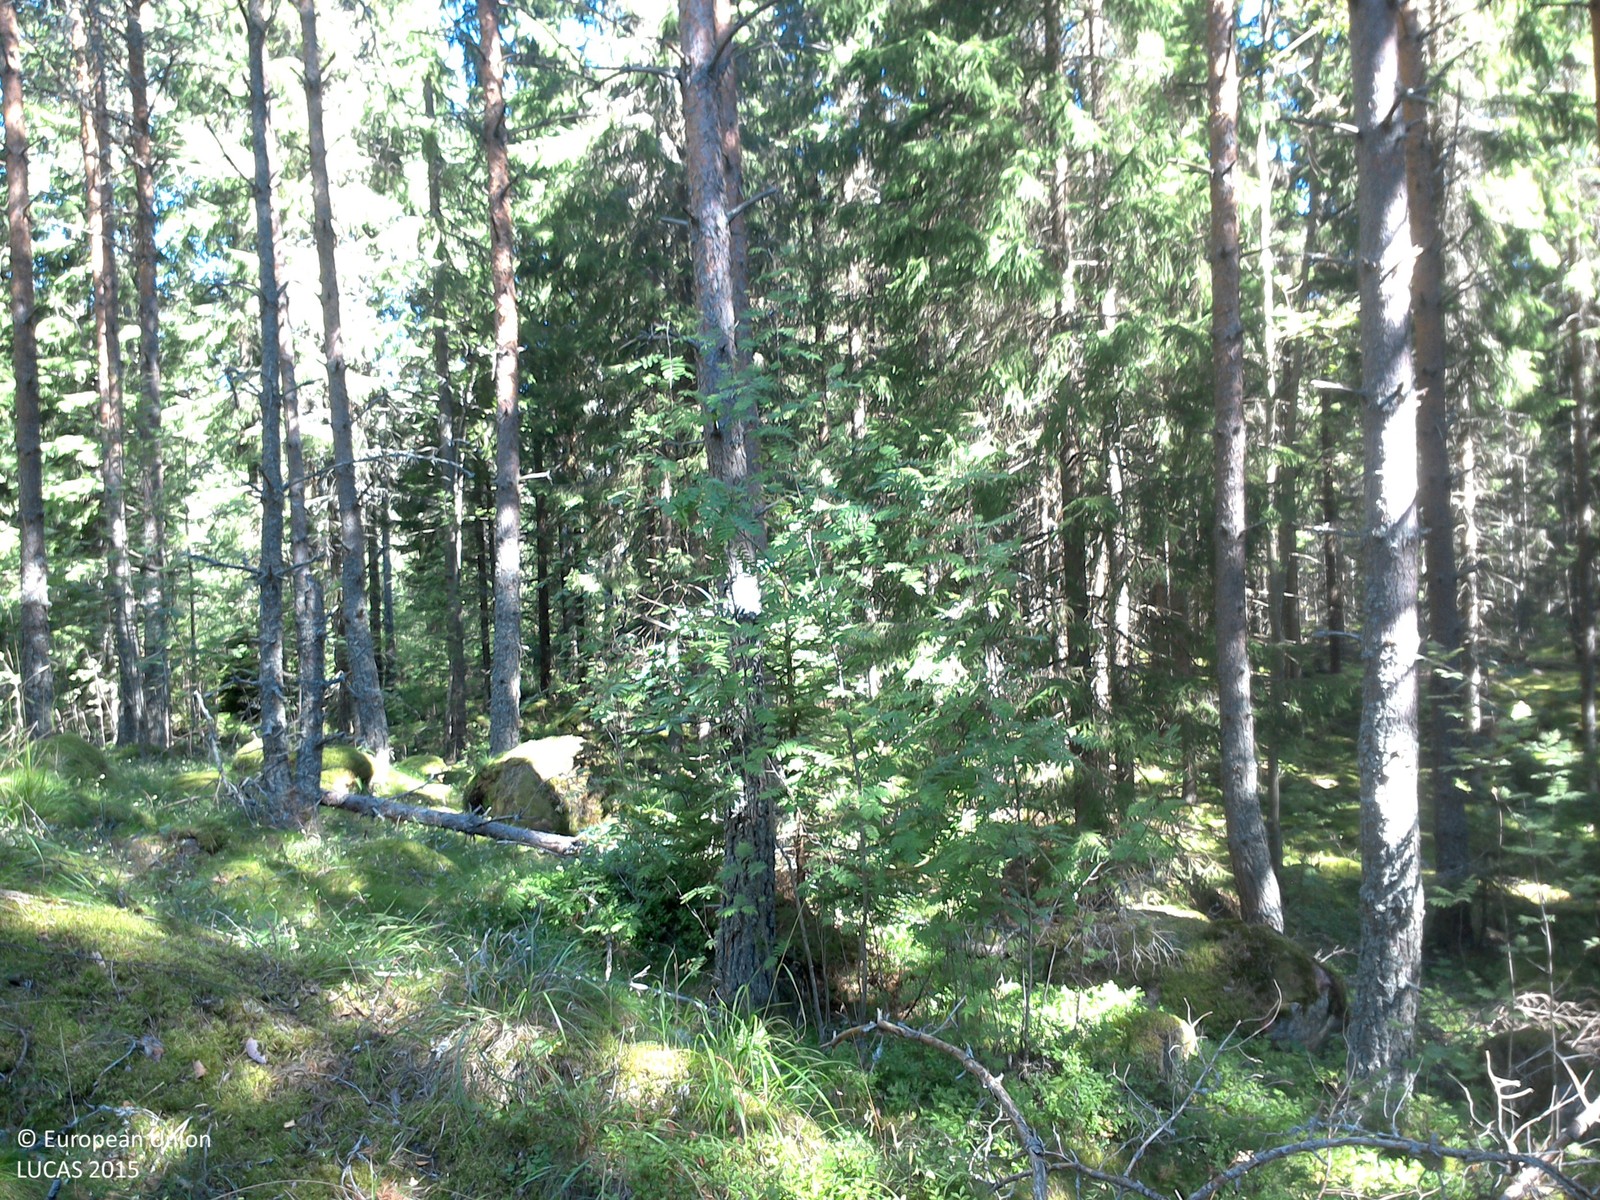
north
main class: Woodland
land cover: Pine dominated coniferous woodland
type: boreal forest
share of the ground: 25 - 50 %
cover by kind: coniferous forest trees 50 %, lichens and mosses 40 %, herbaceous plants 10 %
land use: Forestry
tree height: > 5 m
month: August
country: SE
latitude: 58.2148
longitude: 15.0498
